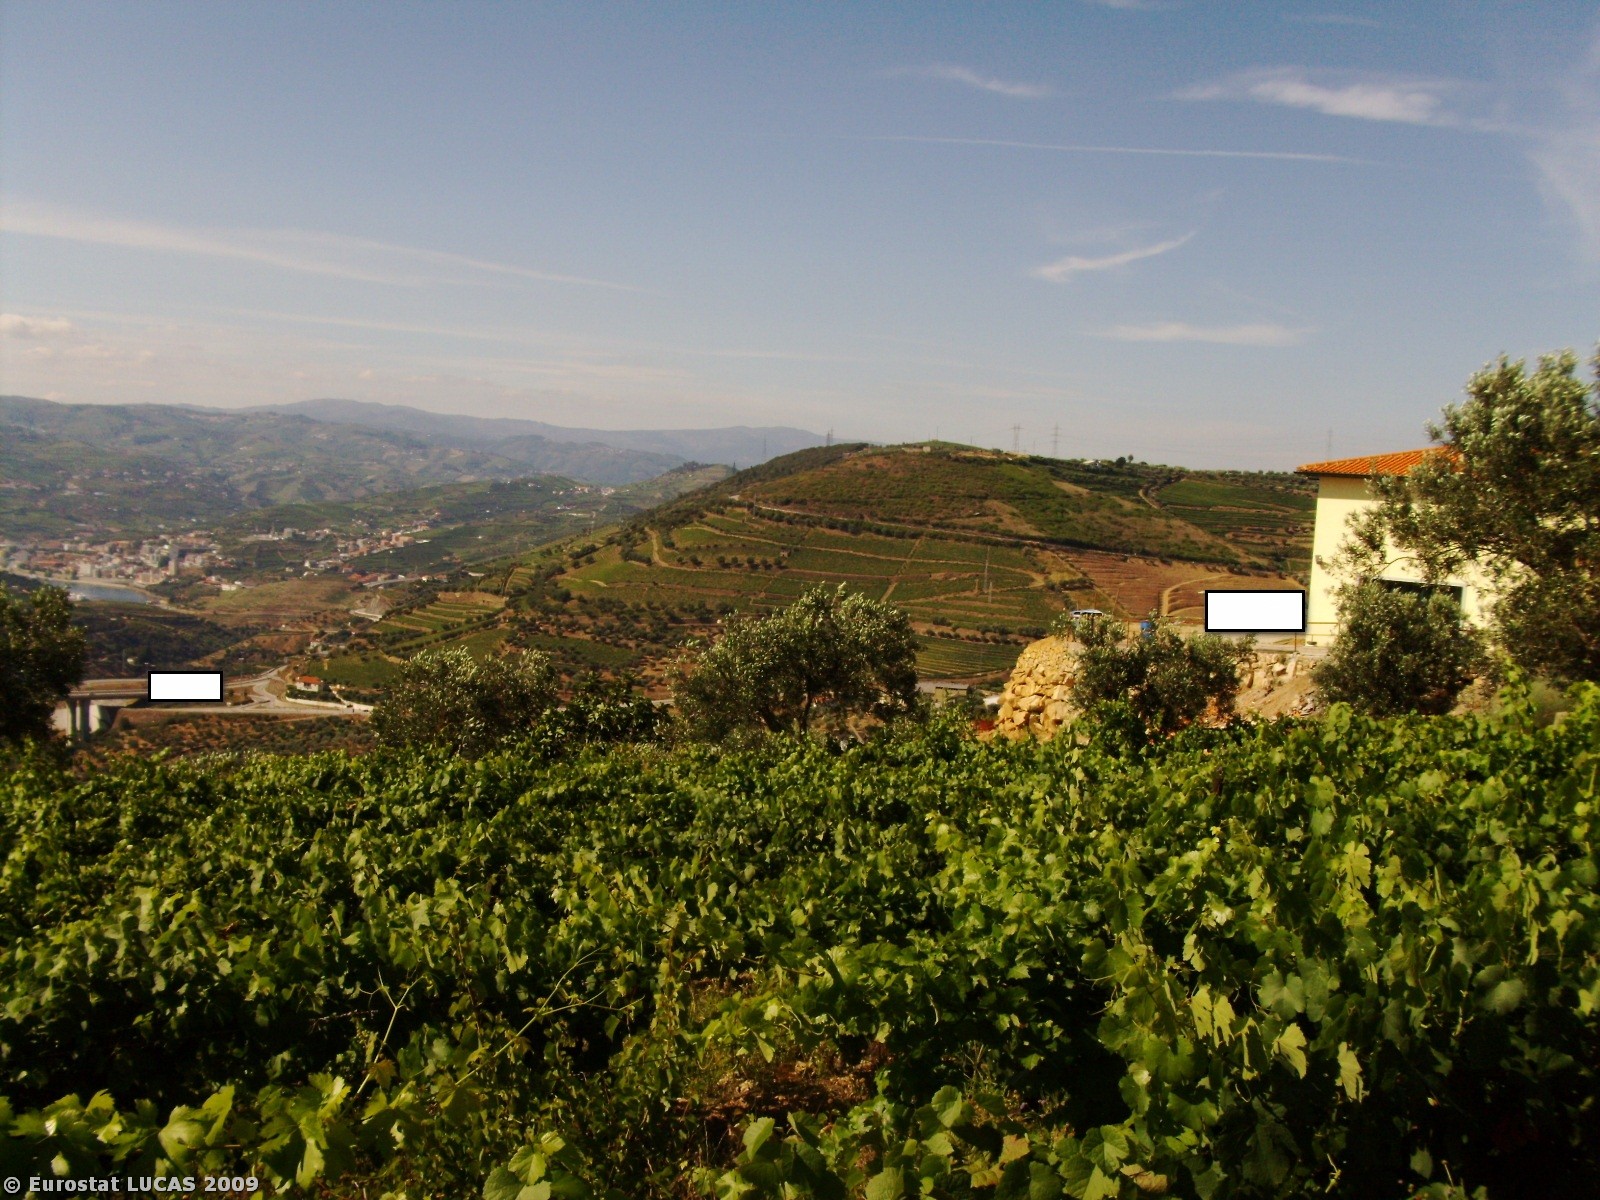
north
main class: Cropland
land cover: Vineyards
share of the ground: 25 - 50 %
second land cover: Bare land
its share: > 75 %
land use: Agriculture (excluding fallow land and kitchen gardens)
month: July
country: PT
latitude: 41.1234
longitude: -7.7681
